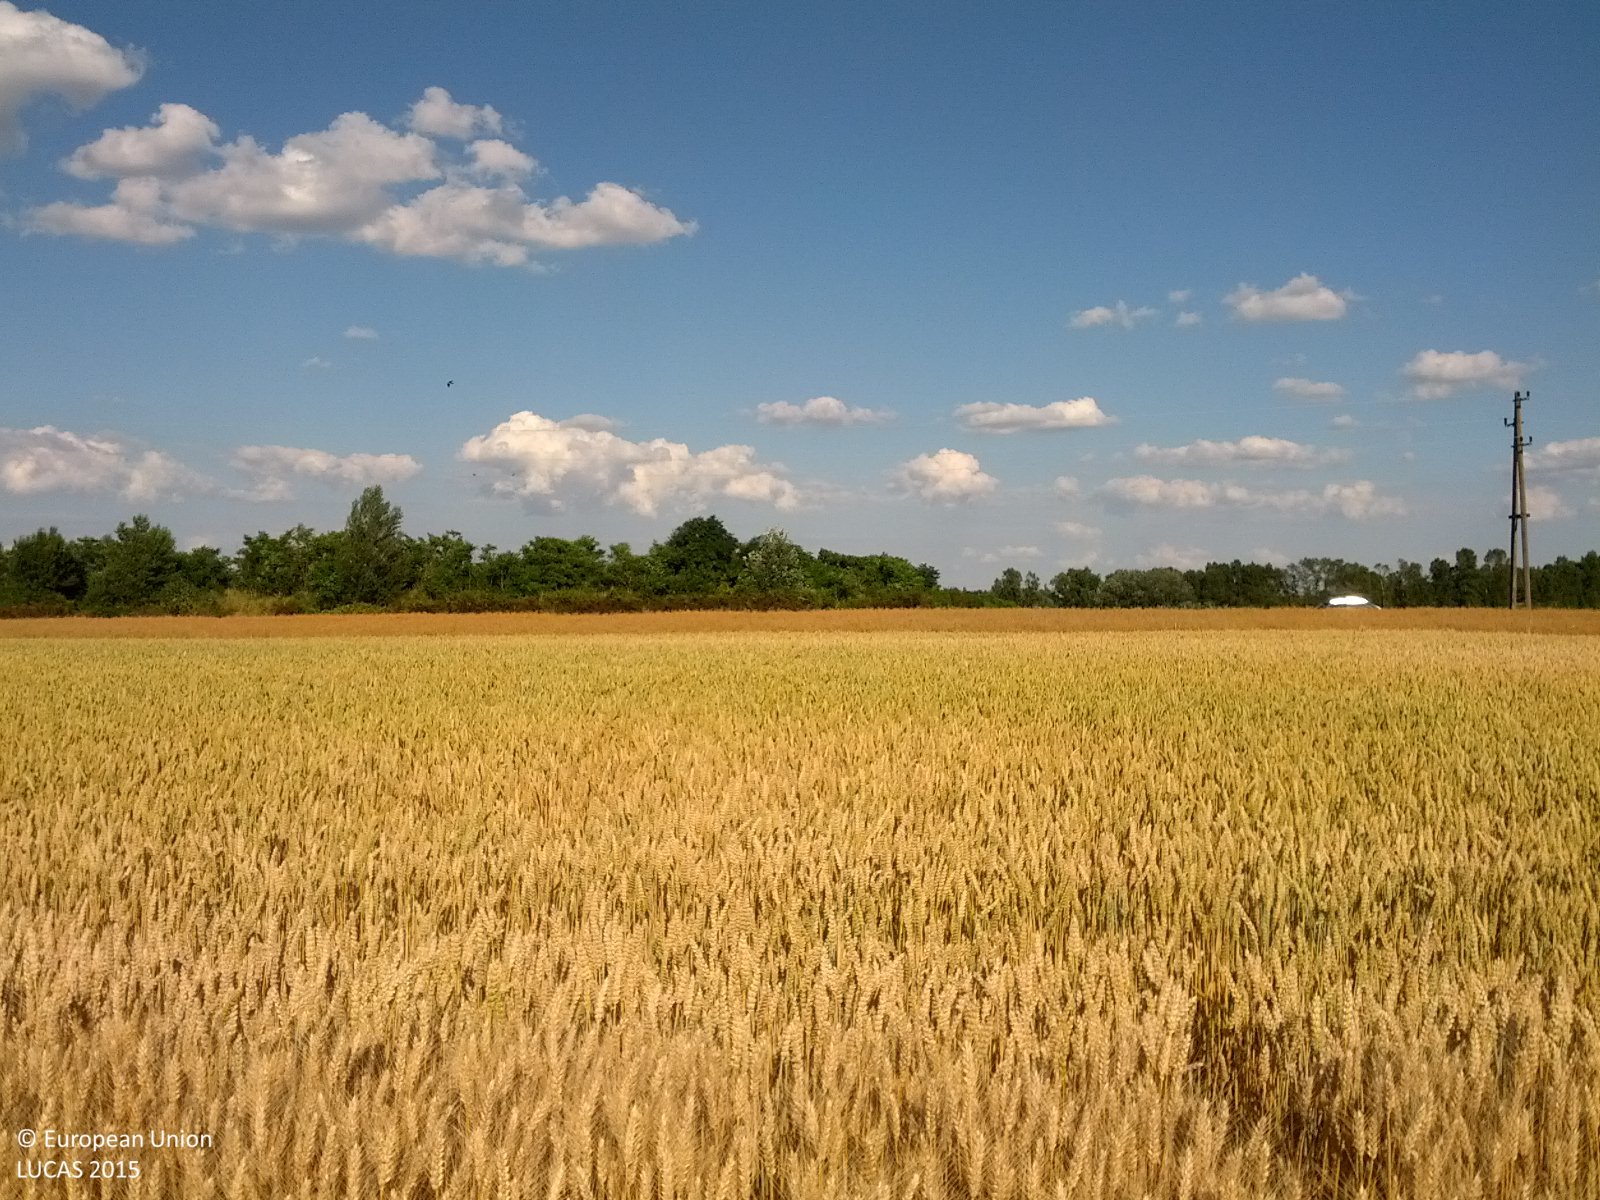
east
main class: Cropland
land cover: Common wheat
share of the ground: > 75 %
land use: Agriculture (excluding fallow land and kitchen gardens)
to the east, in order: Common wheat; Electric lines; Common wheat; Peatbogs; Grass margins; Paved roads, cycling and walking lanes; Grass margins; Common wheat; Fences; Abandoned hedges; Broadleaved woodland; Inland fresh water bodies
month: June
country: AT
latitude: 48.2867
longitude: 16.4611
